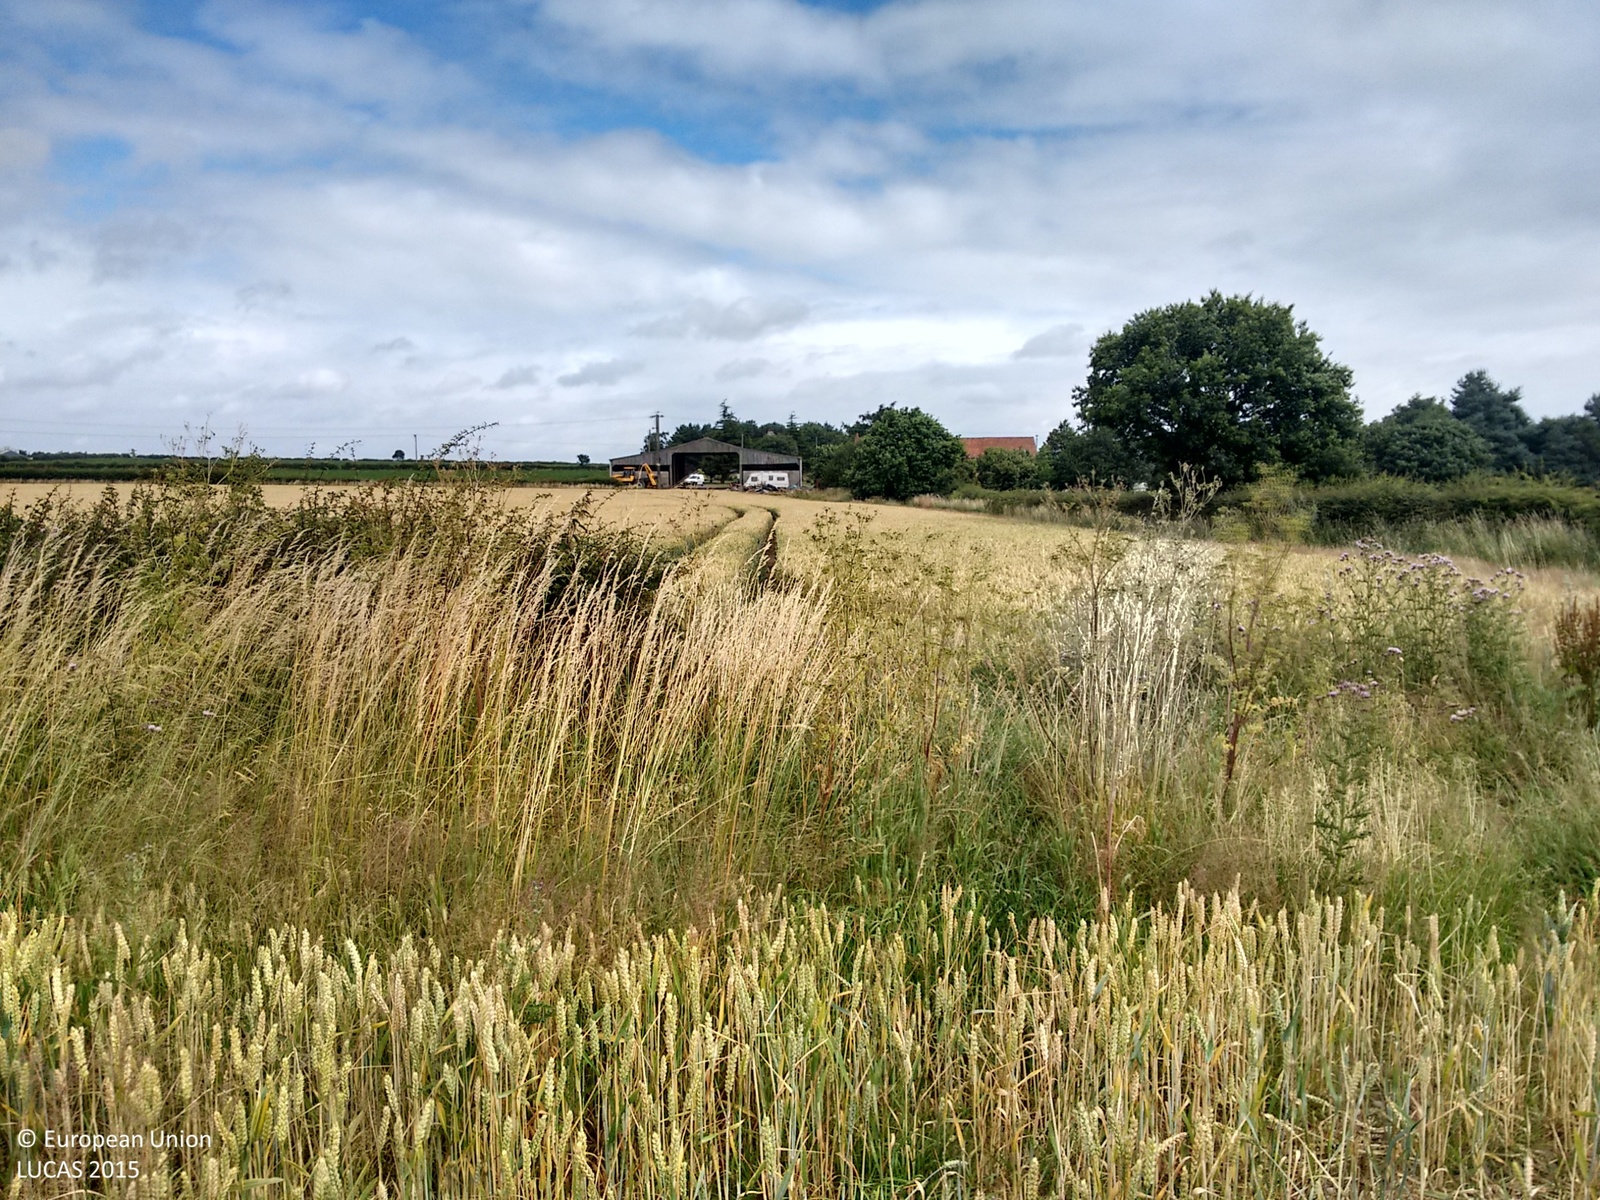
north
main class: Cropland
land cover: Common wheat
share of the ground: > 75 %
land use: Agriculture (excluding fallow land and kitchen gardens)
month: July
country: GB
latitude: 53.0915
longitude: -1.0797
